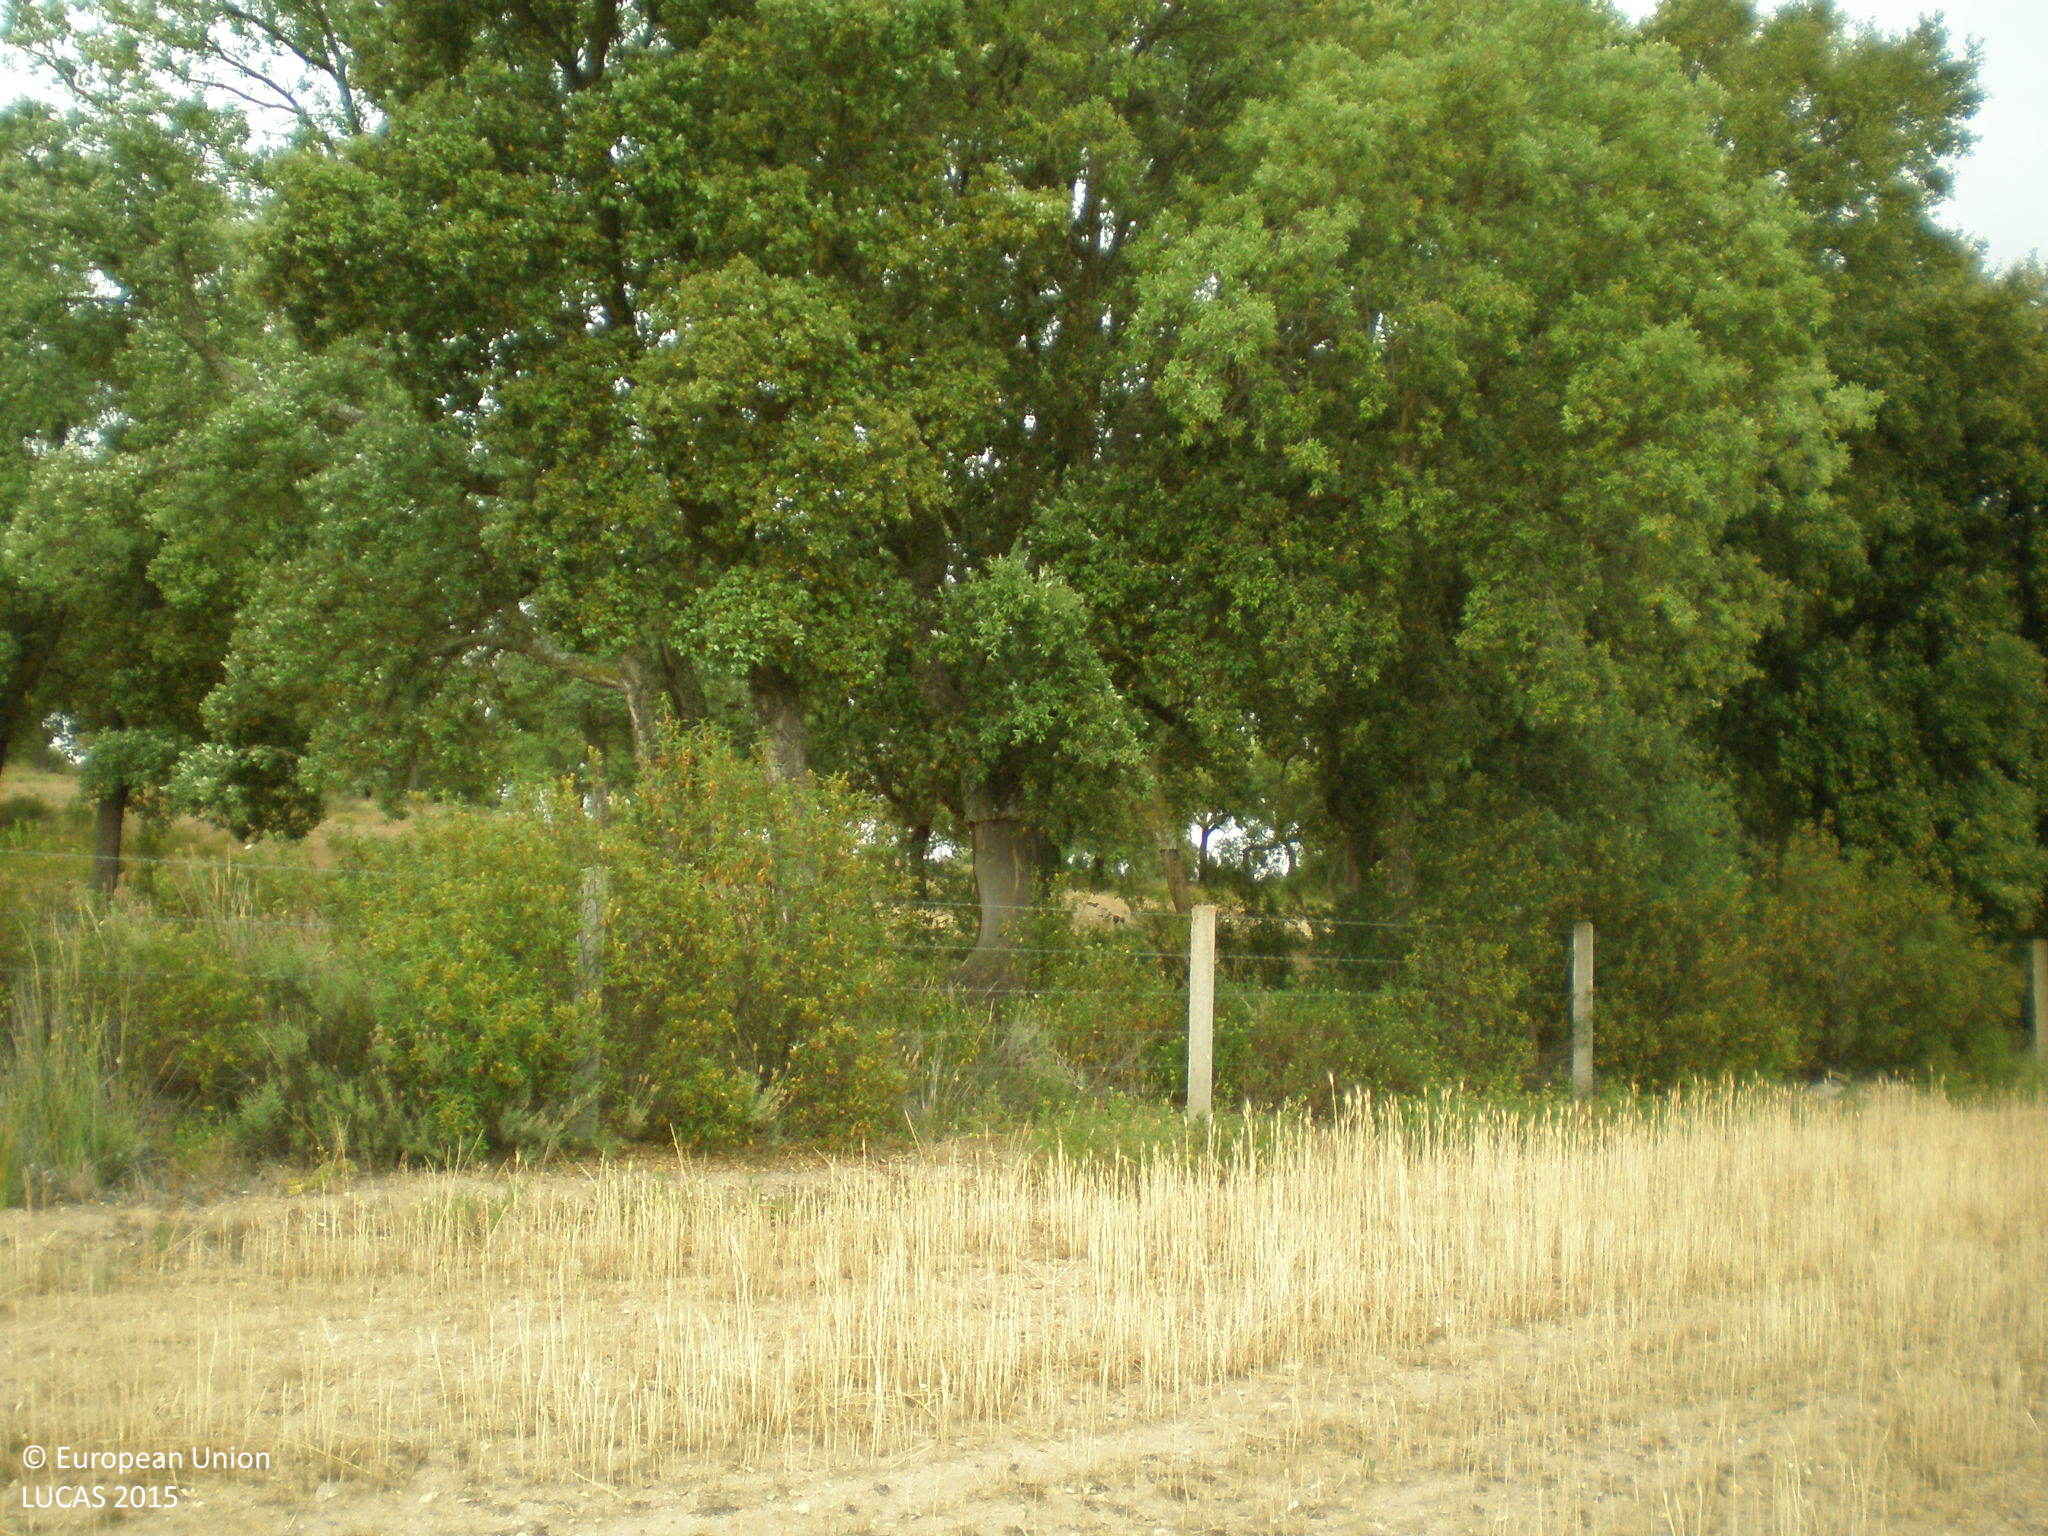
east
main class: Cropland
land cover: Triticale
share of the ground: > 75 %
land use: Agriculture (excluding fallow land and kitchen gardens)
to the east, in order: Triticale; Fences; Broadleaved woodland; Tracks; Broadleaved woodland; Vineyards; Shrubland with sparse tree cover
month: June
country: ES
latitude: 41.1654
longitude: -5.8032
